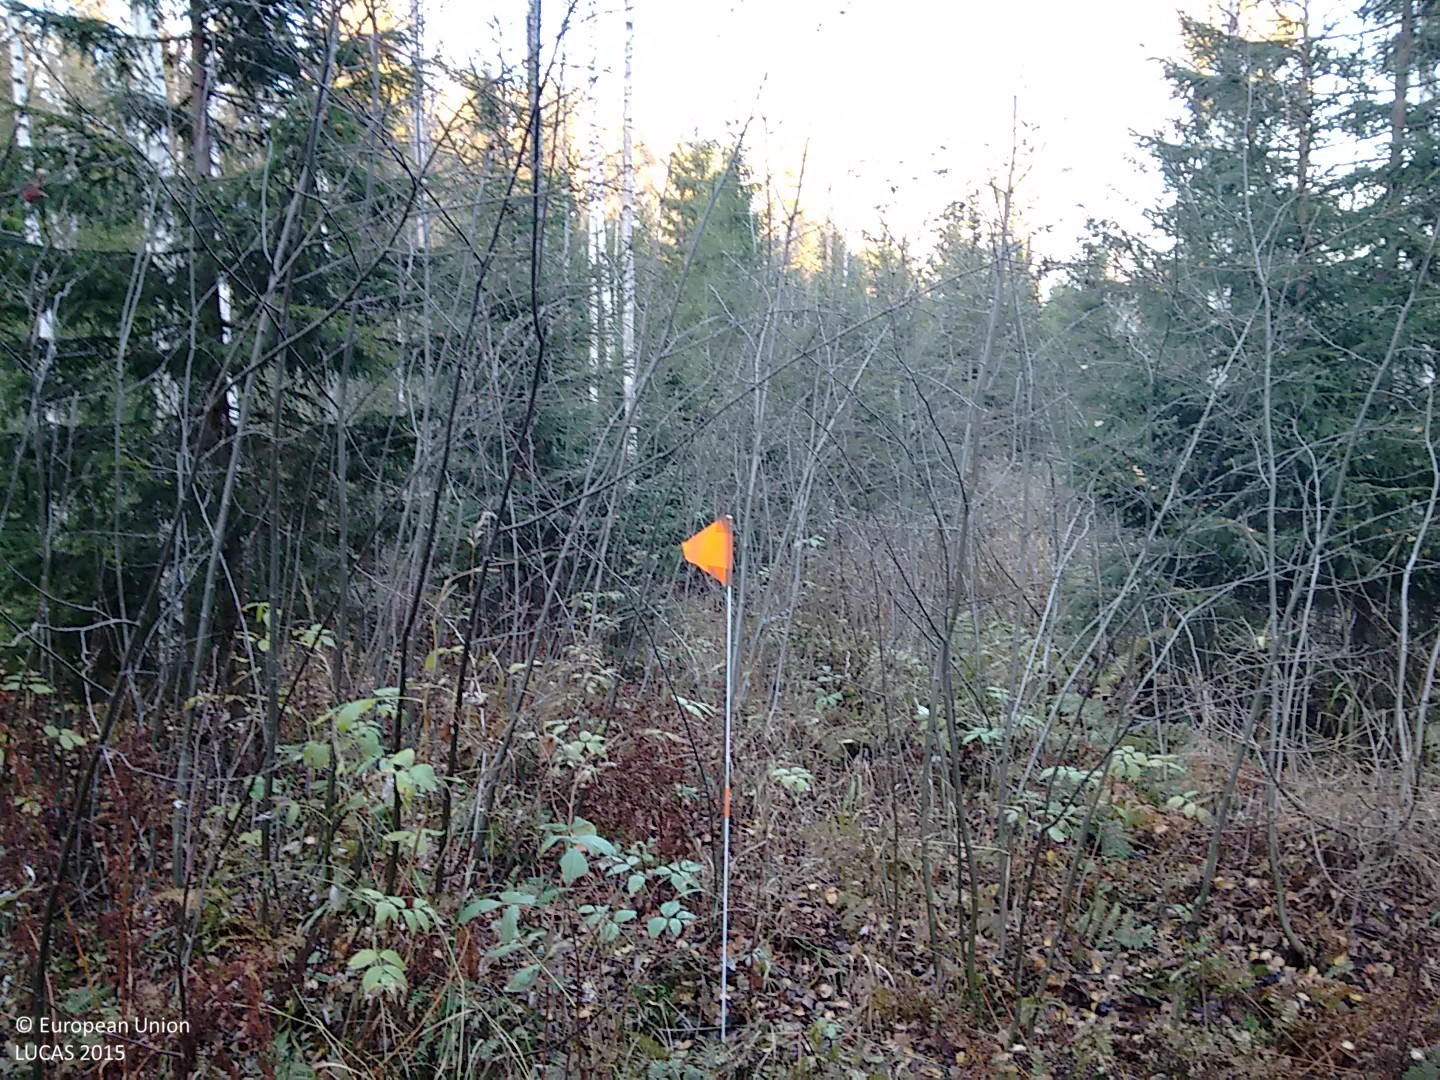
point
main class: Woodland
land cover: Spruce dominated mixed woodland
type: boreal forest
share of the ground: > 75 %
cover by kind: broadleaved forest trees 45 %, coniferous forest trees 40 %, shrubs 10 %, herbaceous plants 5 %
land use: Forestry
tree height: > 5 m
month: October
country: FI
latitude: 62.8430
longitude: 26.1292
